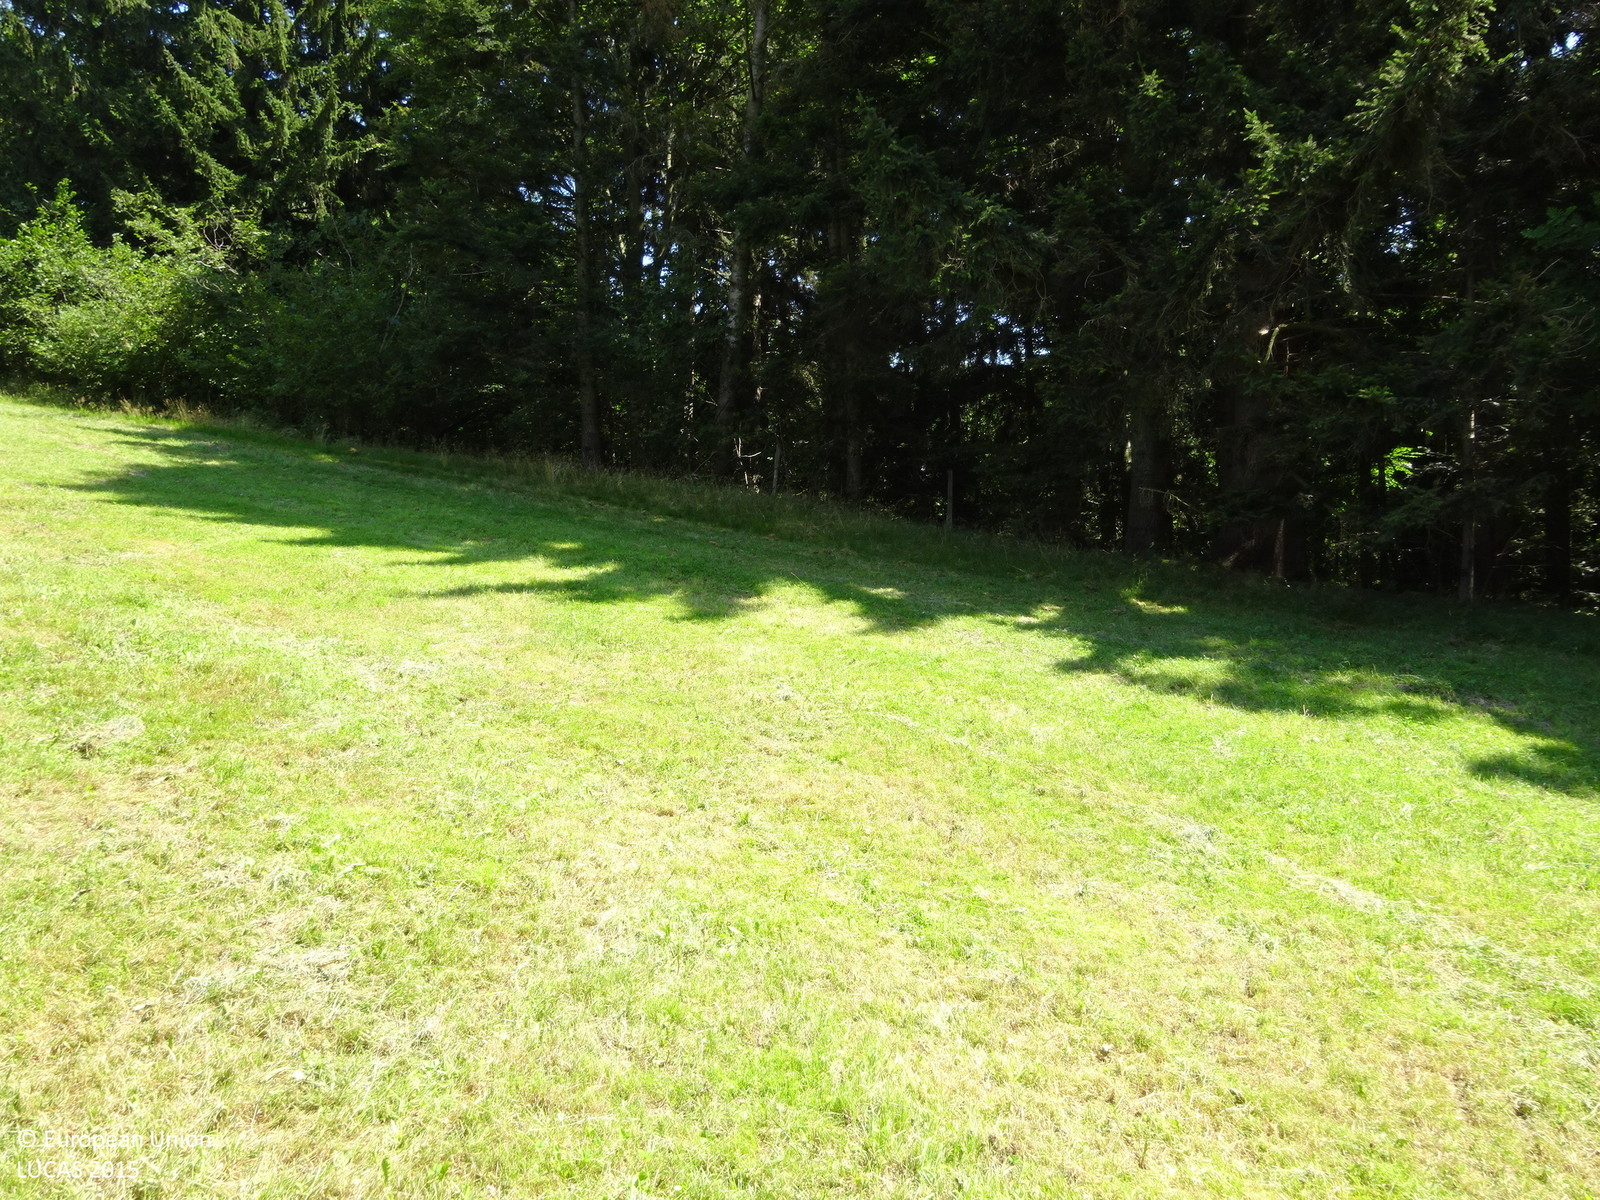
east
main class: Grassland
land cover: Grassland without tree/shrub cover
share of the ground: > 75 %
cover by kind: herbaceous plants 100 %
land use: Agriculture (excluding fallow land and kitchen gardens)
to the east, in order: Grassland without tree/shrub cover; Fences; Spruce dominated mixed woodland; Broadleaved woodland; Spruce dominated mixed woodland; Rivers and streams; Spruce dominated mixed woodland
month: August
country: AT
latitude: 47.4969
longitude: 16.0688
